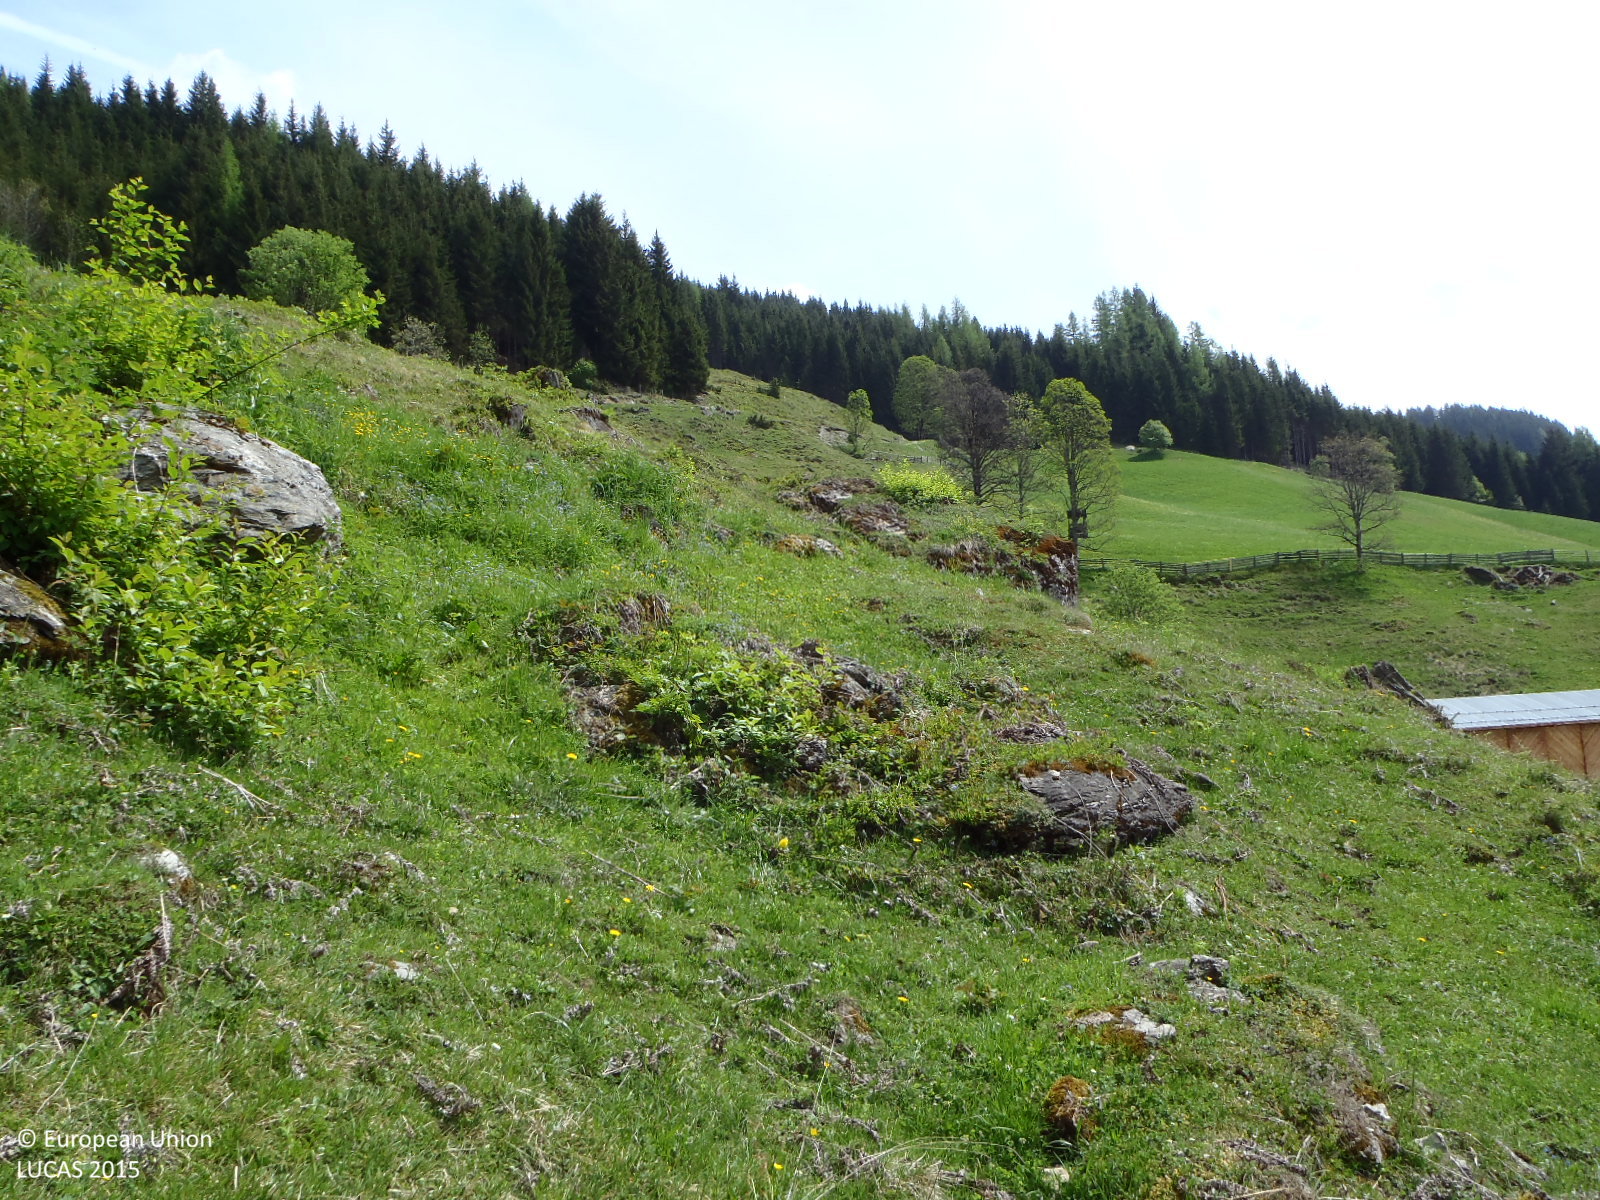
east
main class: Grassland
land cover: Grassland without tree/shrub cover
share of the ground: > 75 %
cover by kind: herbaceous plants 90 %, unconsolidated bare surface 10 %
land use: Agriculture (excluding fallow land and kitchen gardens)
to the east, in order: Grassland without tree/shrub cover; Grassland with sparse tree/shrub cover; Tracks; Grassland without tree/shrub cover; Tracks; Fences; Spruce dominated coniferous woodland; Other coniferous woodland; Grassland without tree/shrub cover; Tracks; Grassland without tree/shrub cover
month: May
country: AT
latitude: 47.2910
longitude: 13.3170
